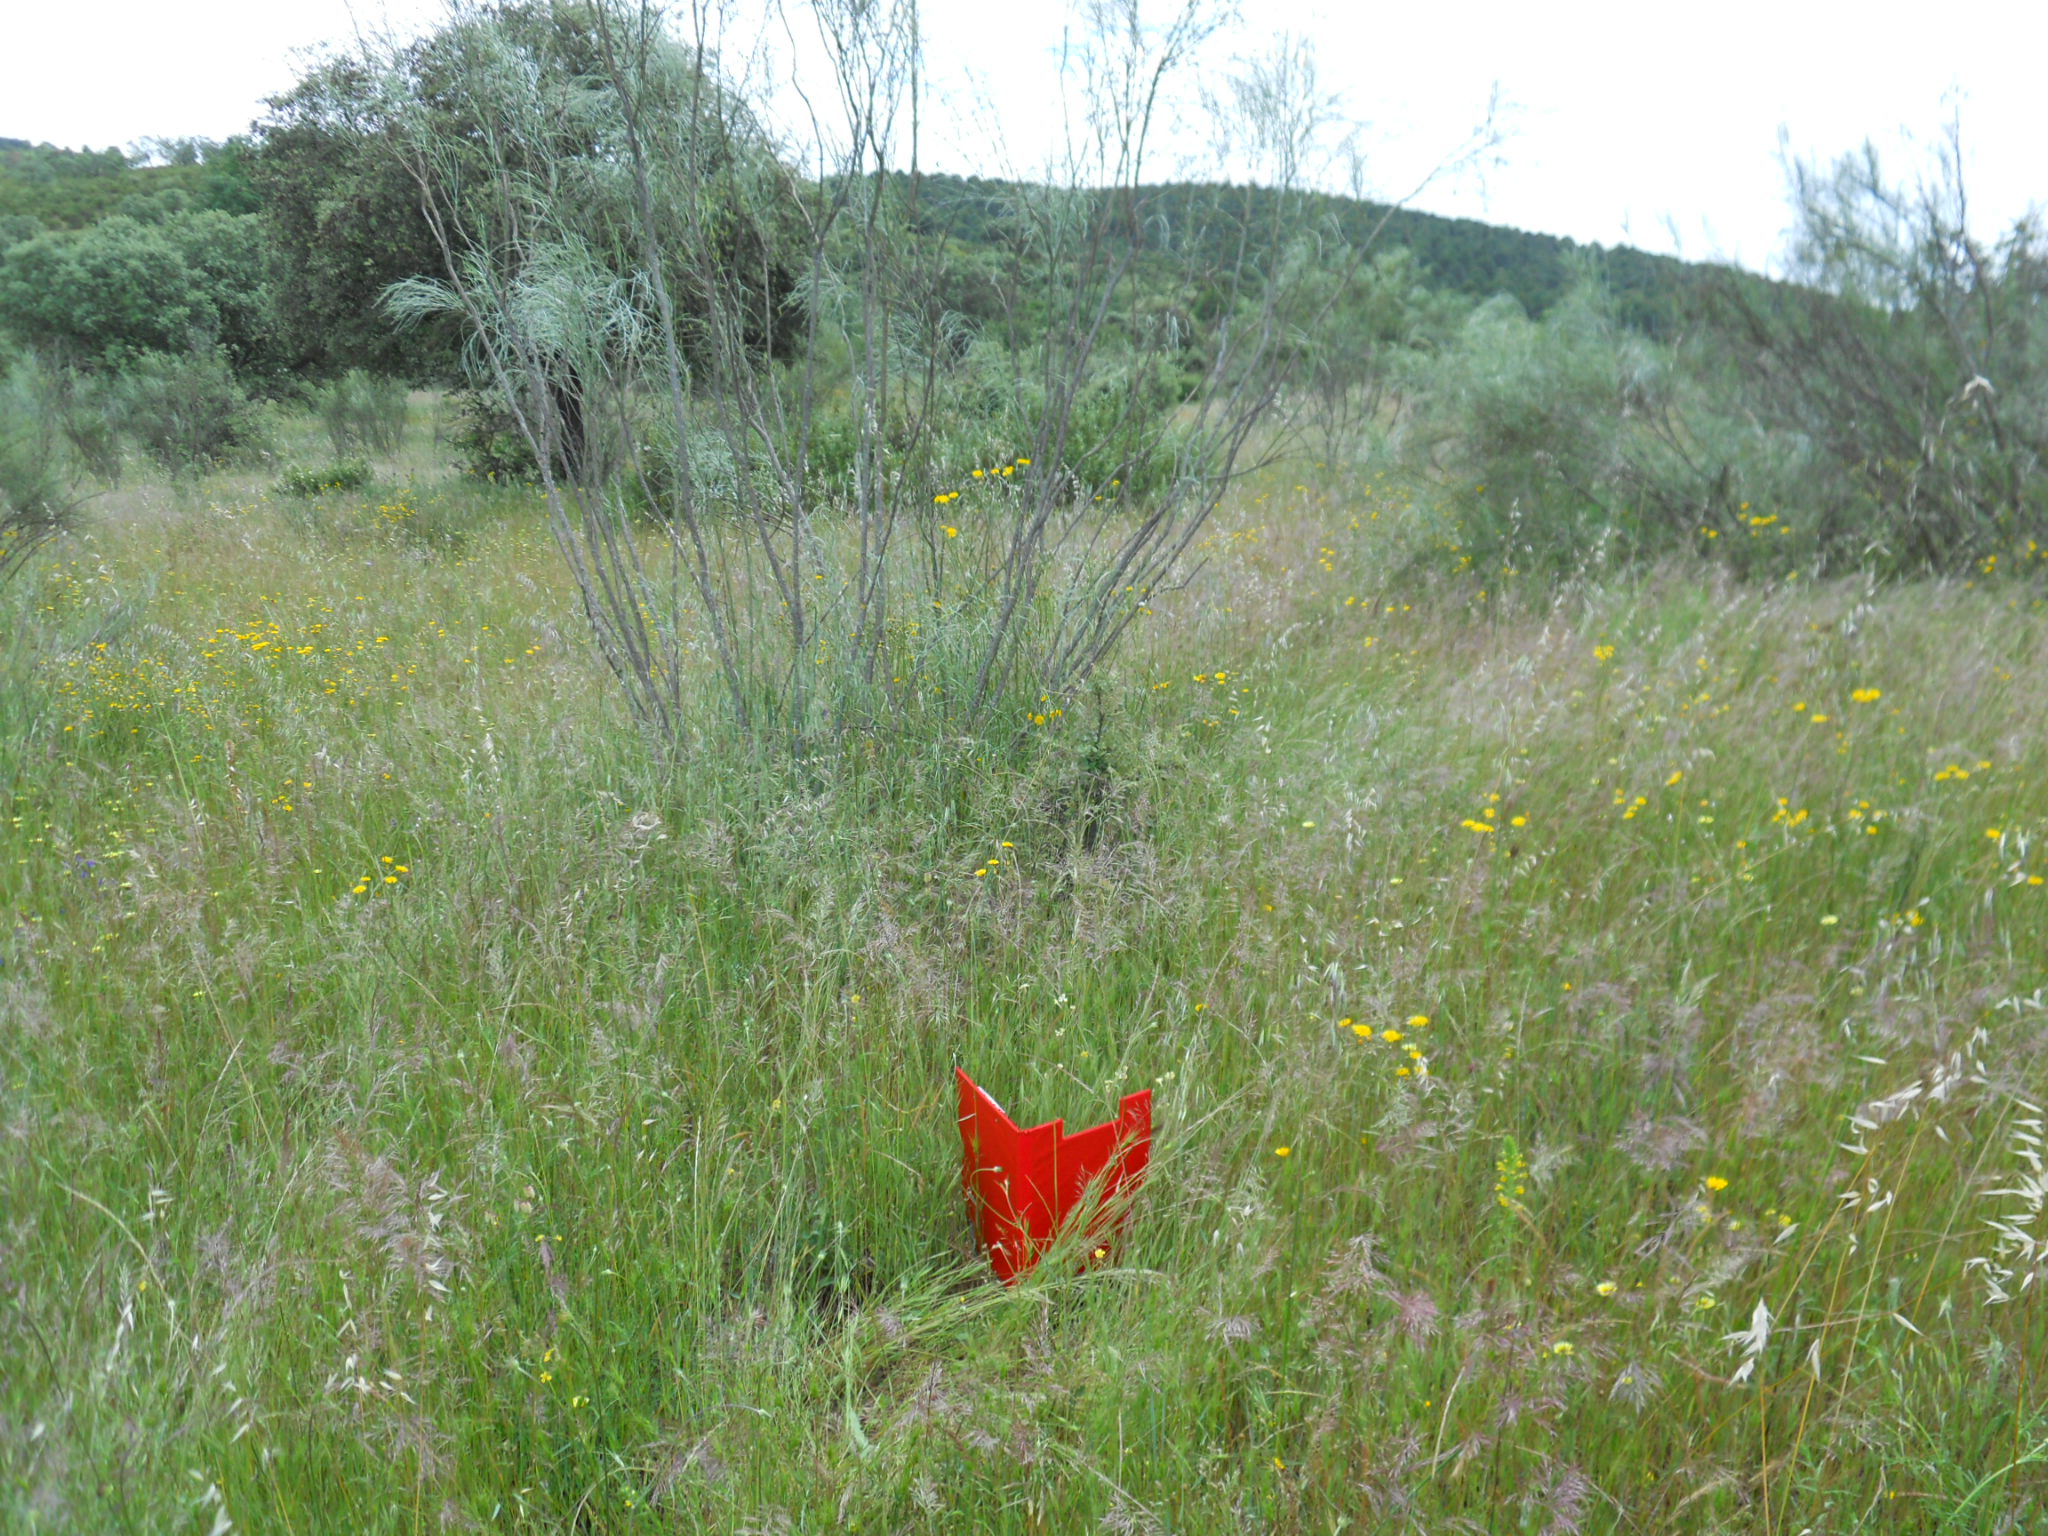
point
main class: Grassland
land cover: Grassland with sparse tree/shrub cover
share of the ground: > 75 %
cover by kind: herbaceous plants 85 %, shrubs 10 %, broadleaved forest trees 5 %
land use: Agriculture (excluding fallow land and kitchen gardens)
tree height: > 5 m
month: May
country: ES
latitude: 39.1536
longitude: -7.0287
